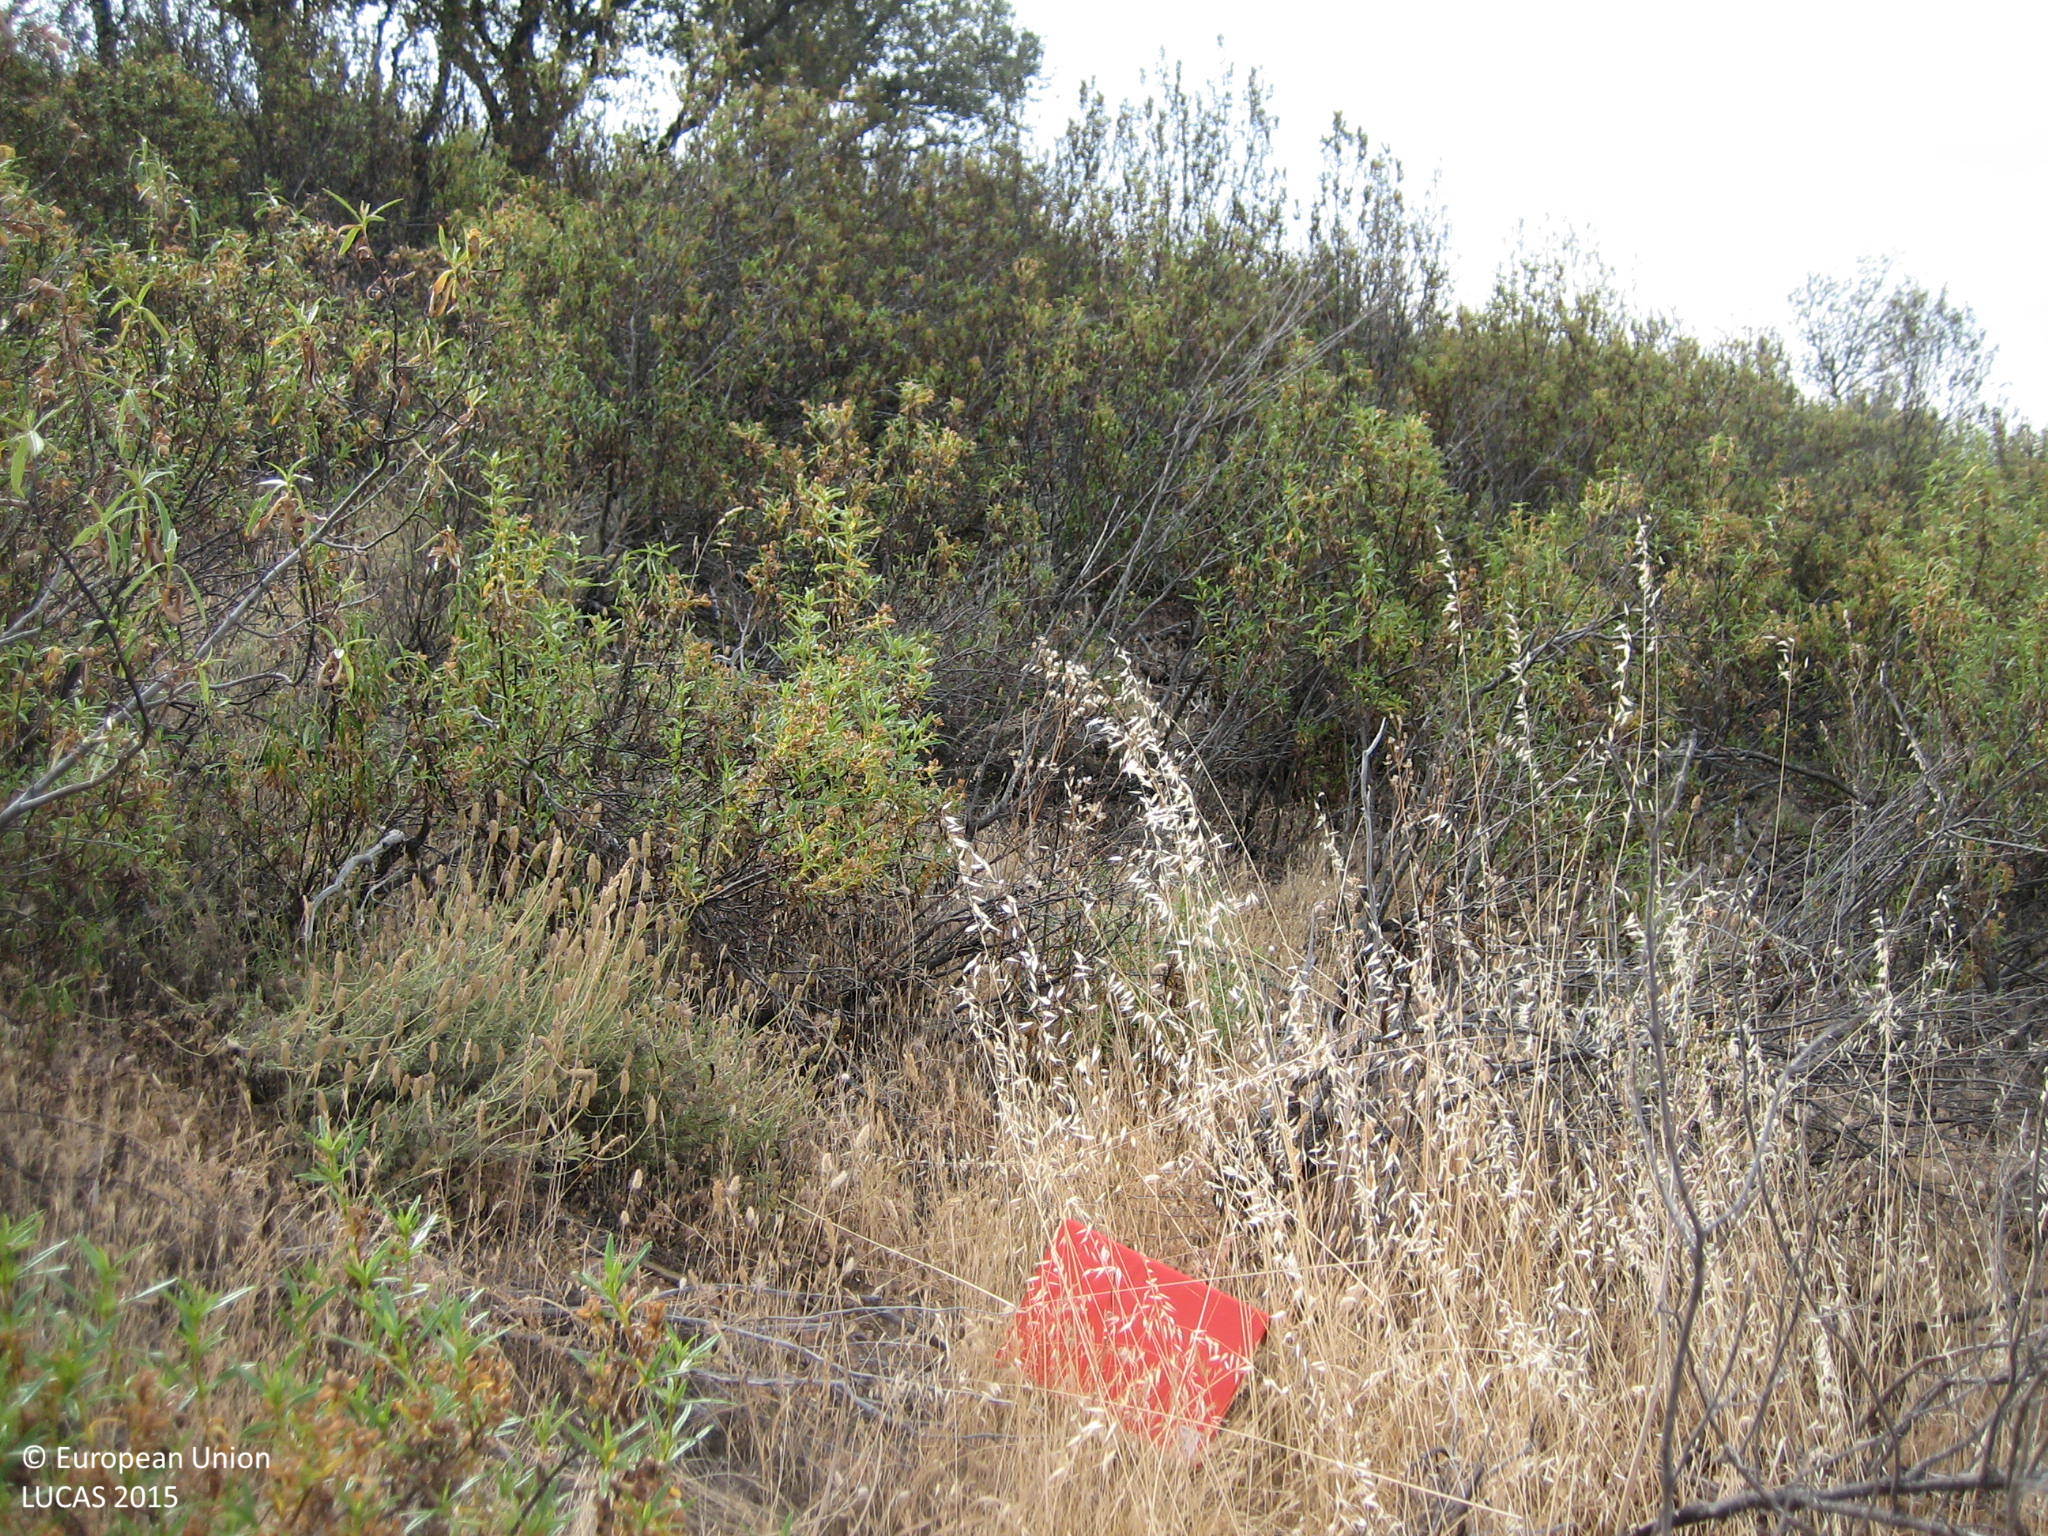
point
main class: Shrubland
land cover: Shrubland with sparse tree cover
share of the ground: > 75 %
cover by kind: shrubs 95 %, broadleaved forest trees 5 %
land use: Semi-natural and natural areas not in use
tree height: < 5 m
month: June
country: ES
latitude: 39.1714
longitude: -4.5814
